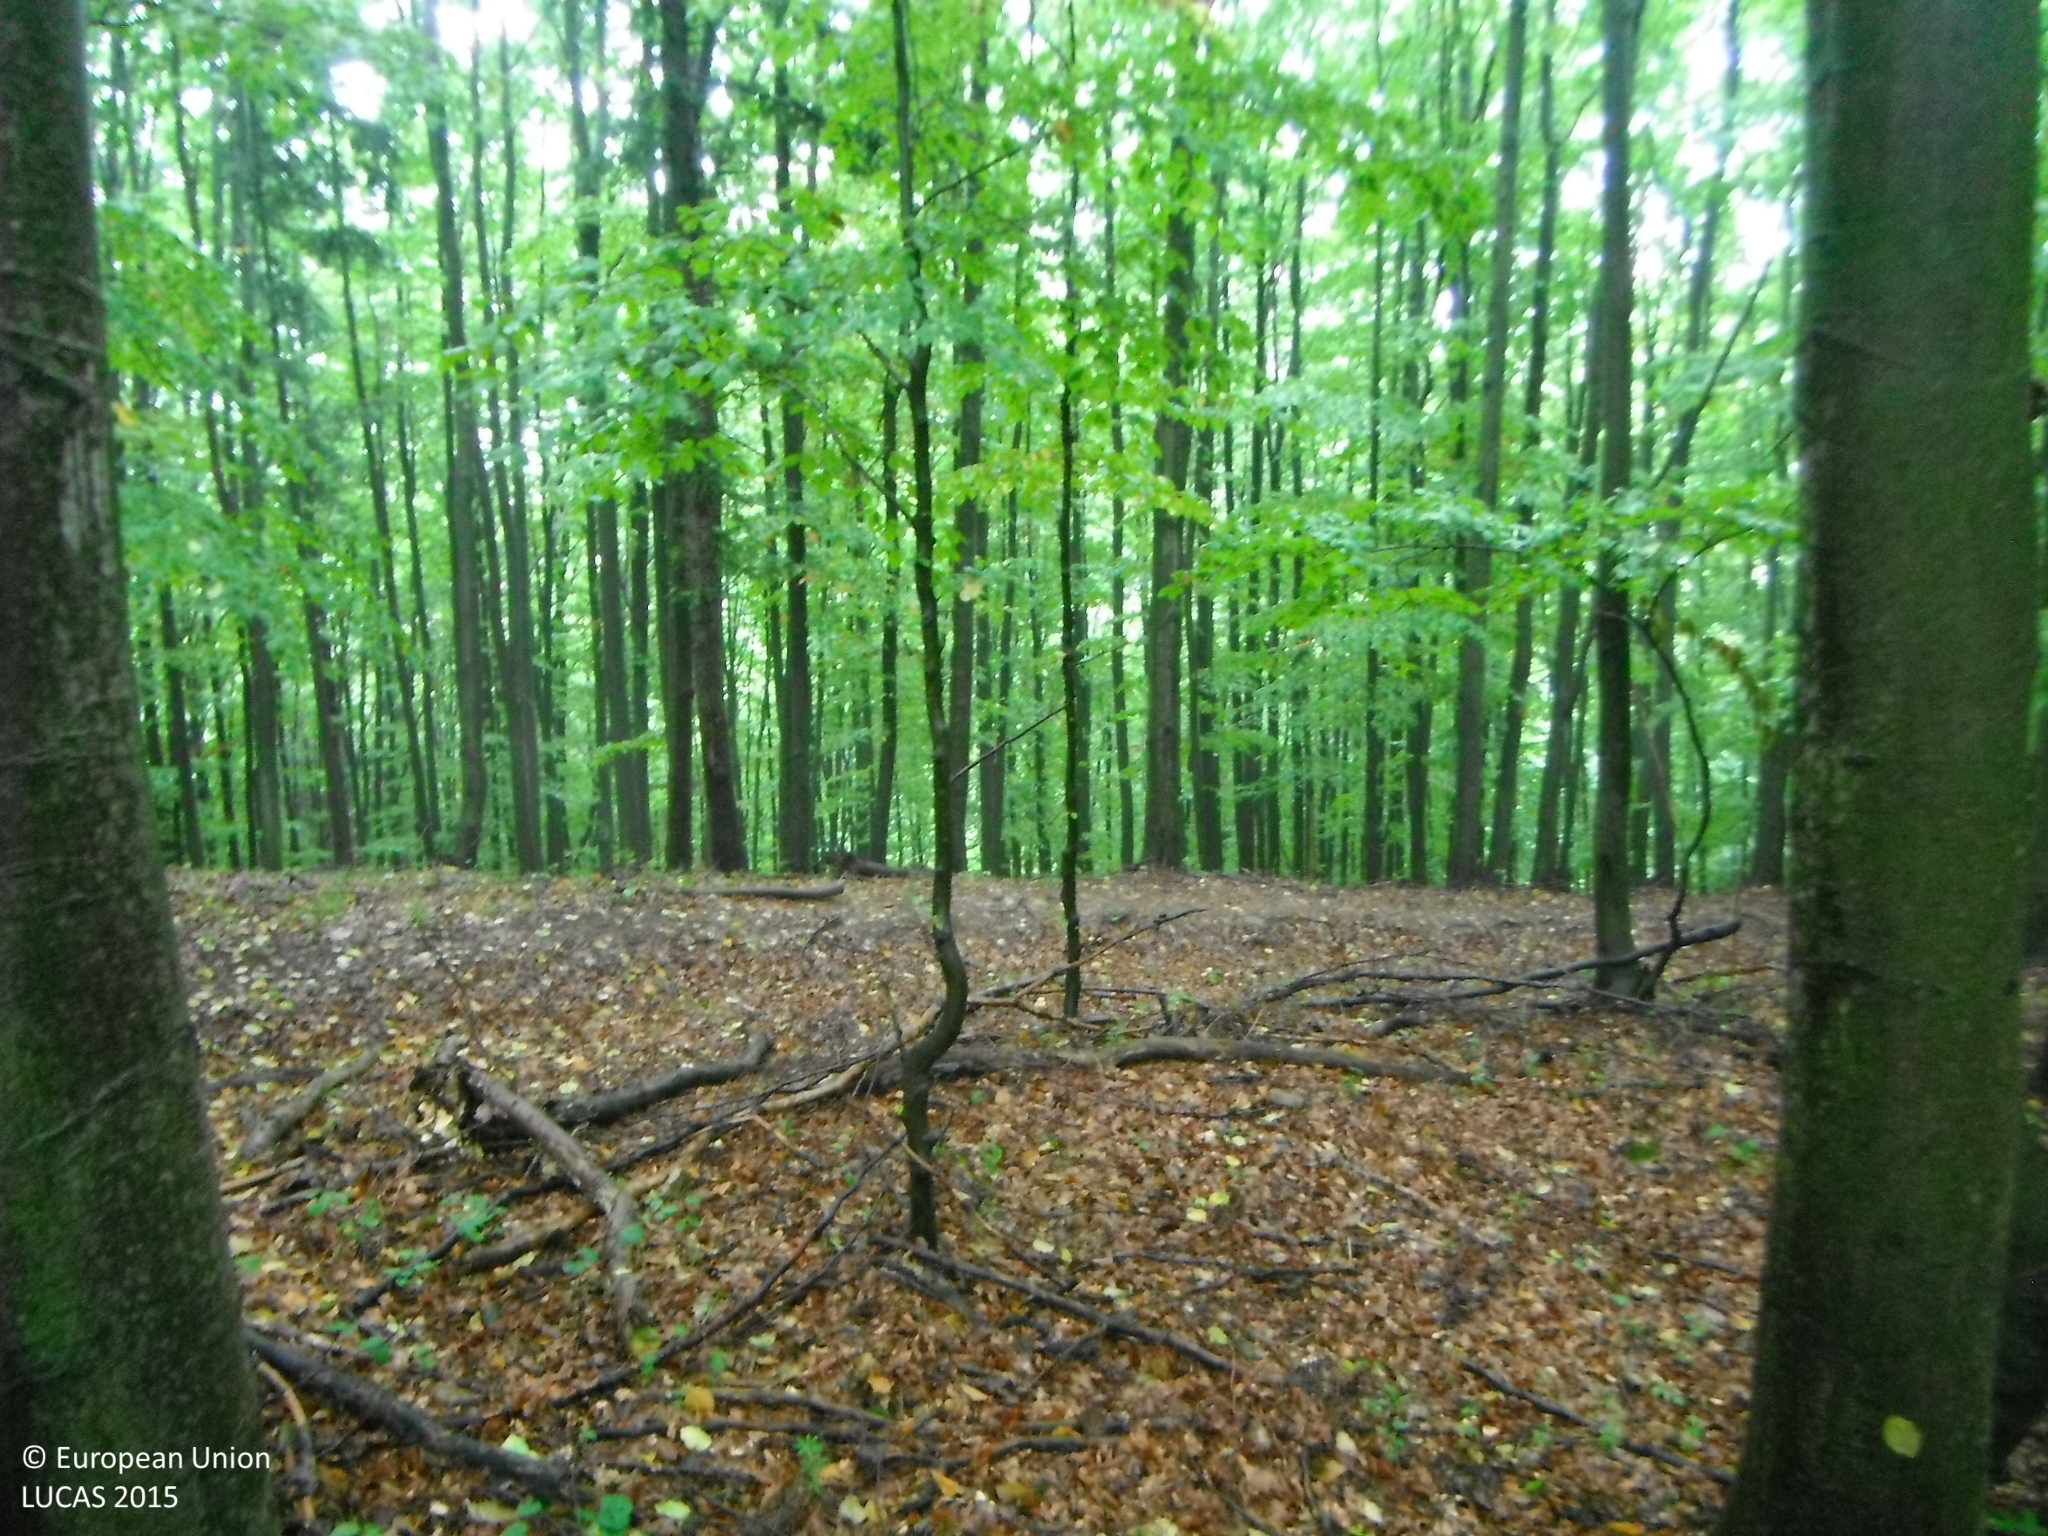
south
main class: Woodland
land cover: Broadleaved woodland
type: beech forest
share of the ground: > 75 %
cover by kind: broadleaved forest trees 100 %
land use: Forestry
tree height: > 5 m
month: August
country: SK
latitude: 48.9381
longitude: 18.5780
